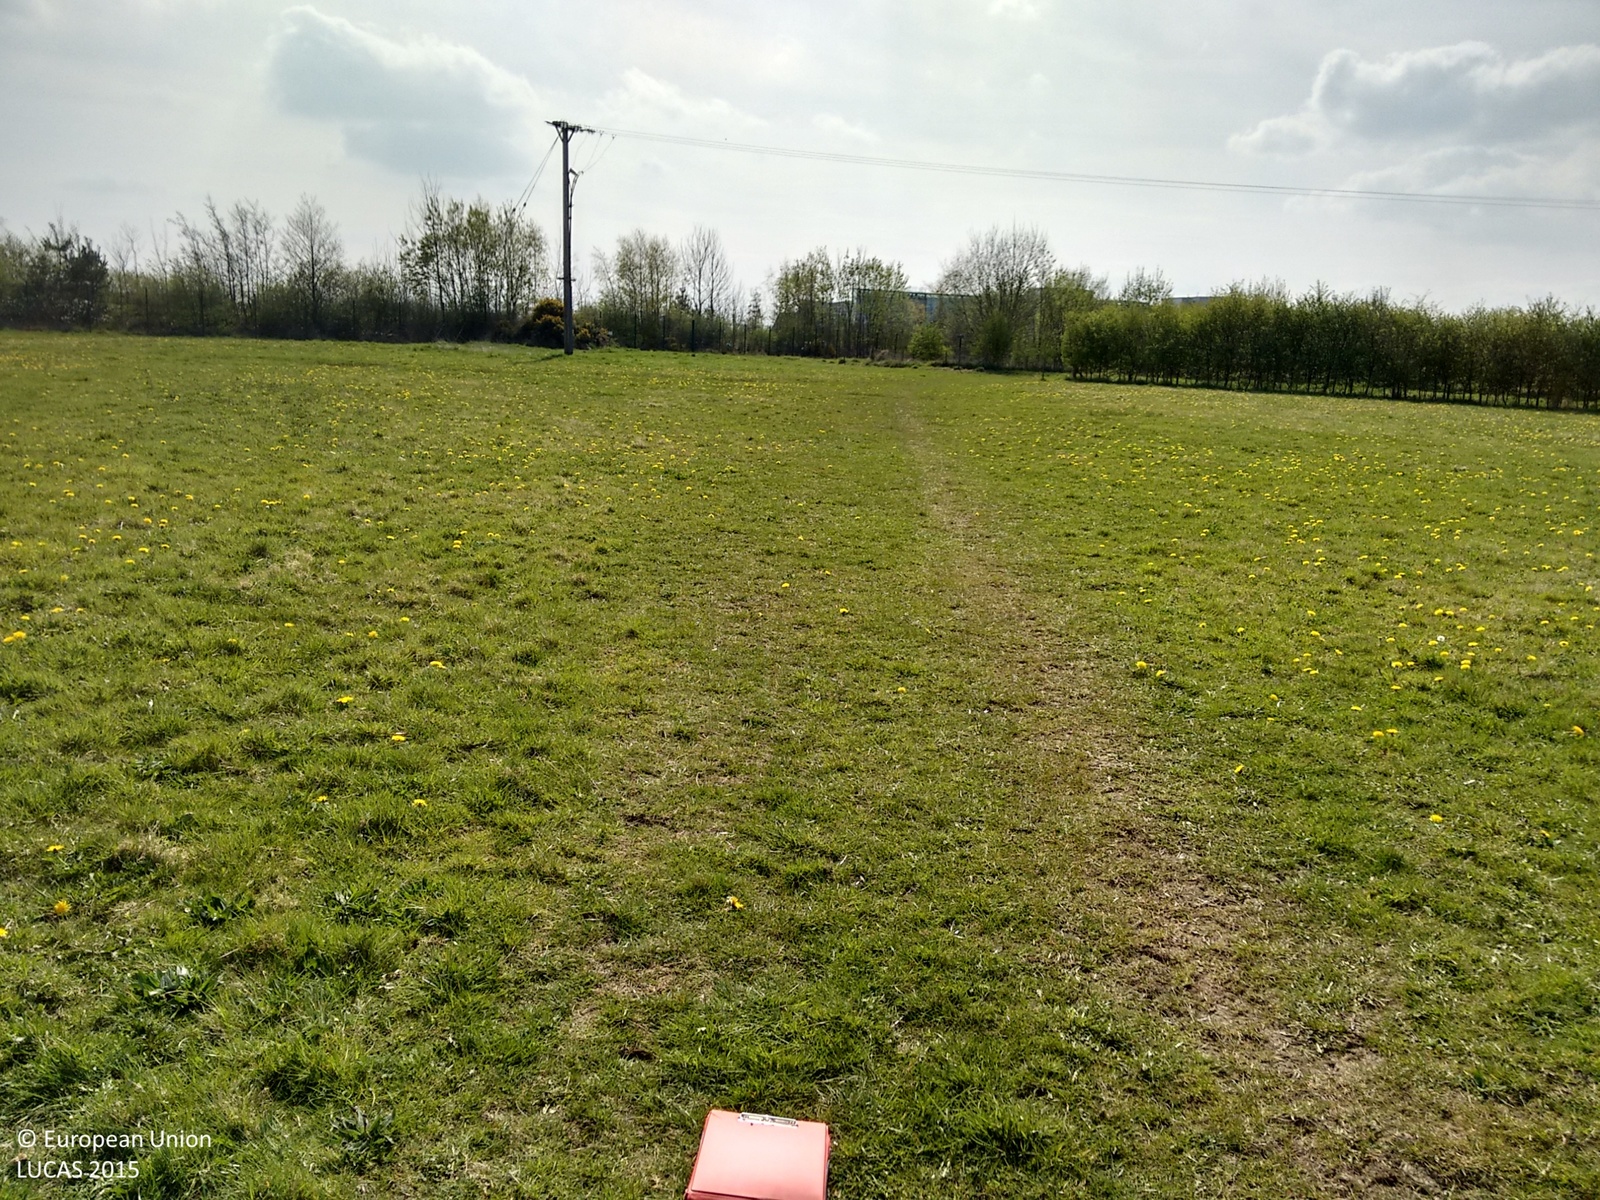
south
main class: Grassland
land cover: Grassland with sparse tree/shrub cover
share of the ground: > 75 %
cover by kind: herbaceous plants 95 %, broadleaved forest trees 5 %
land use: Agriculture (excluding fallow land and kitchen gardens)
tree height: > 5 m
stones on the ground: < 10 %
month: April
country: GB
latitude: 55.0373
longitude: -1.6440
